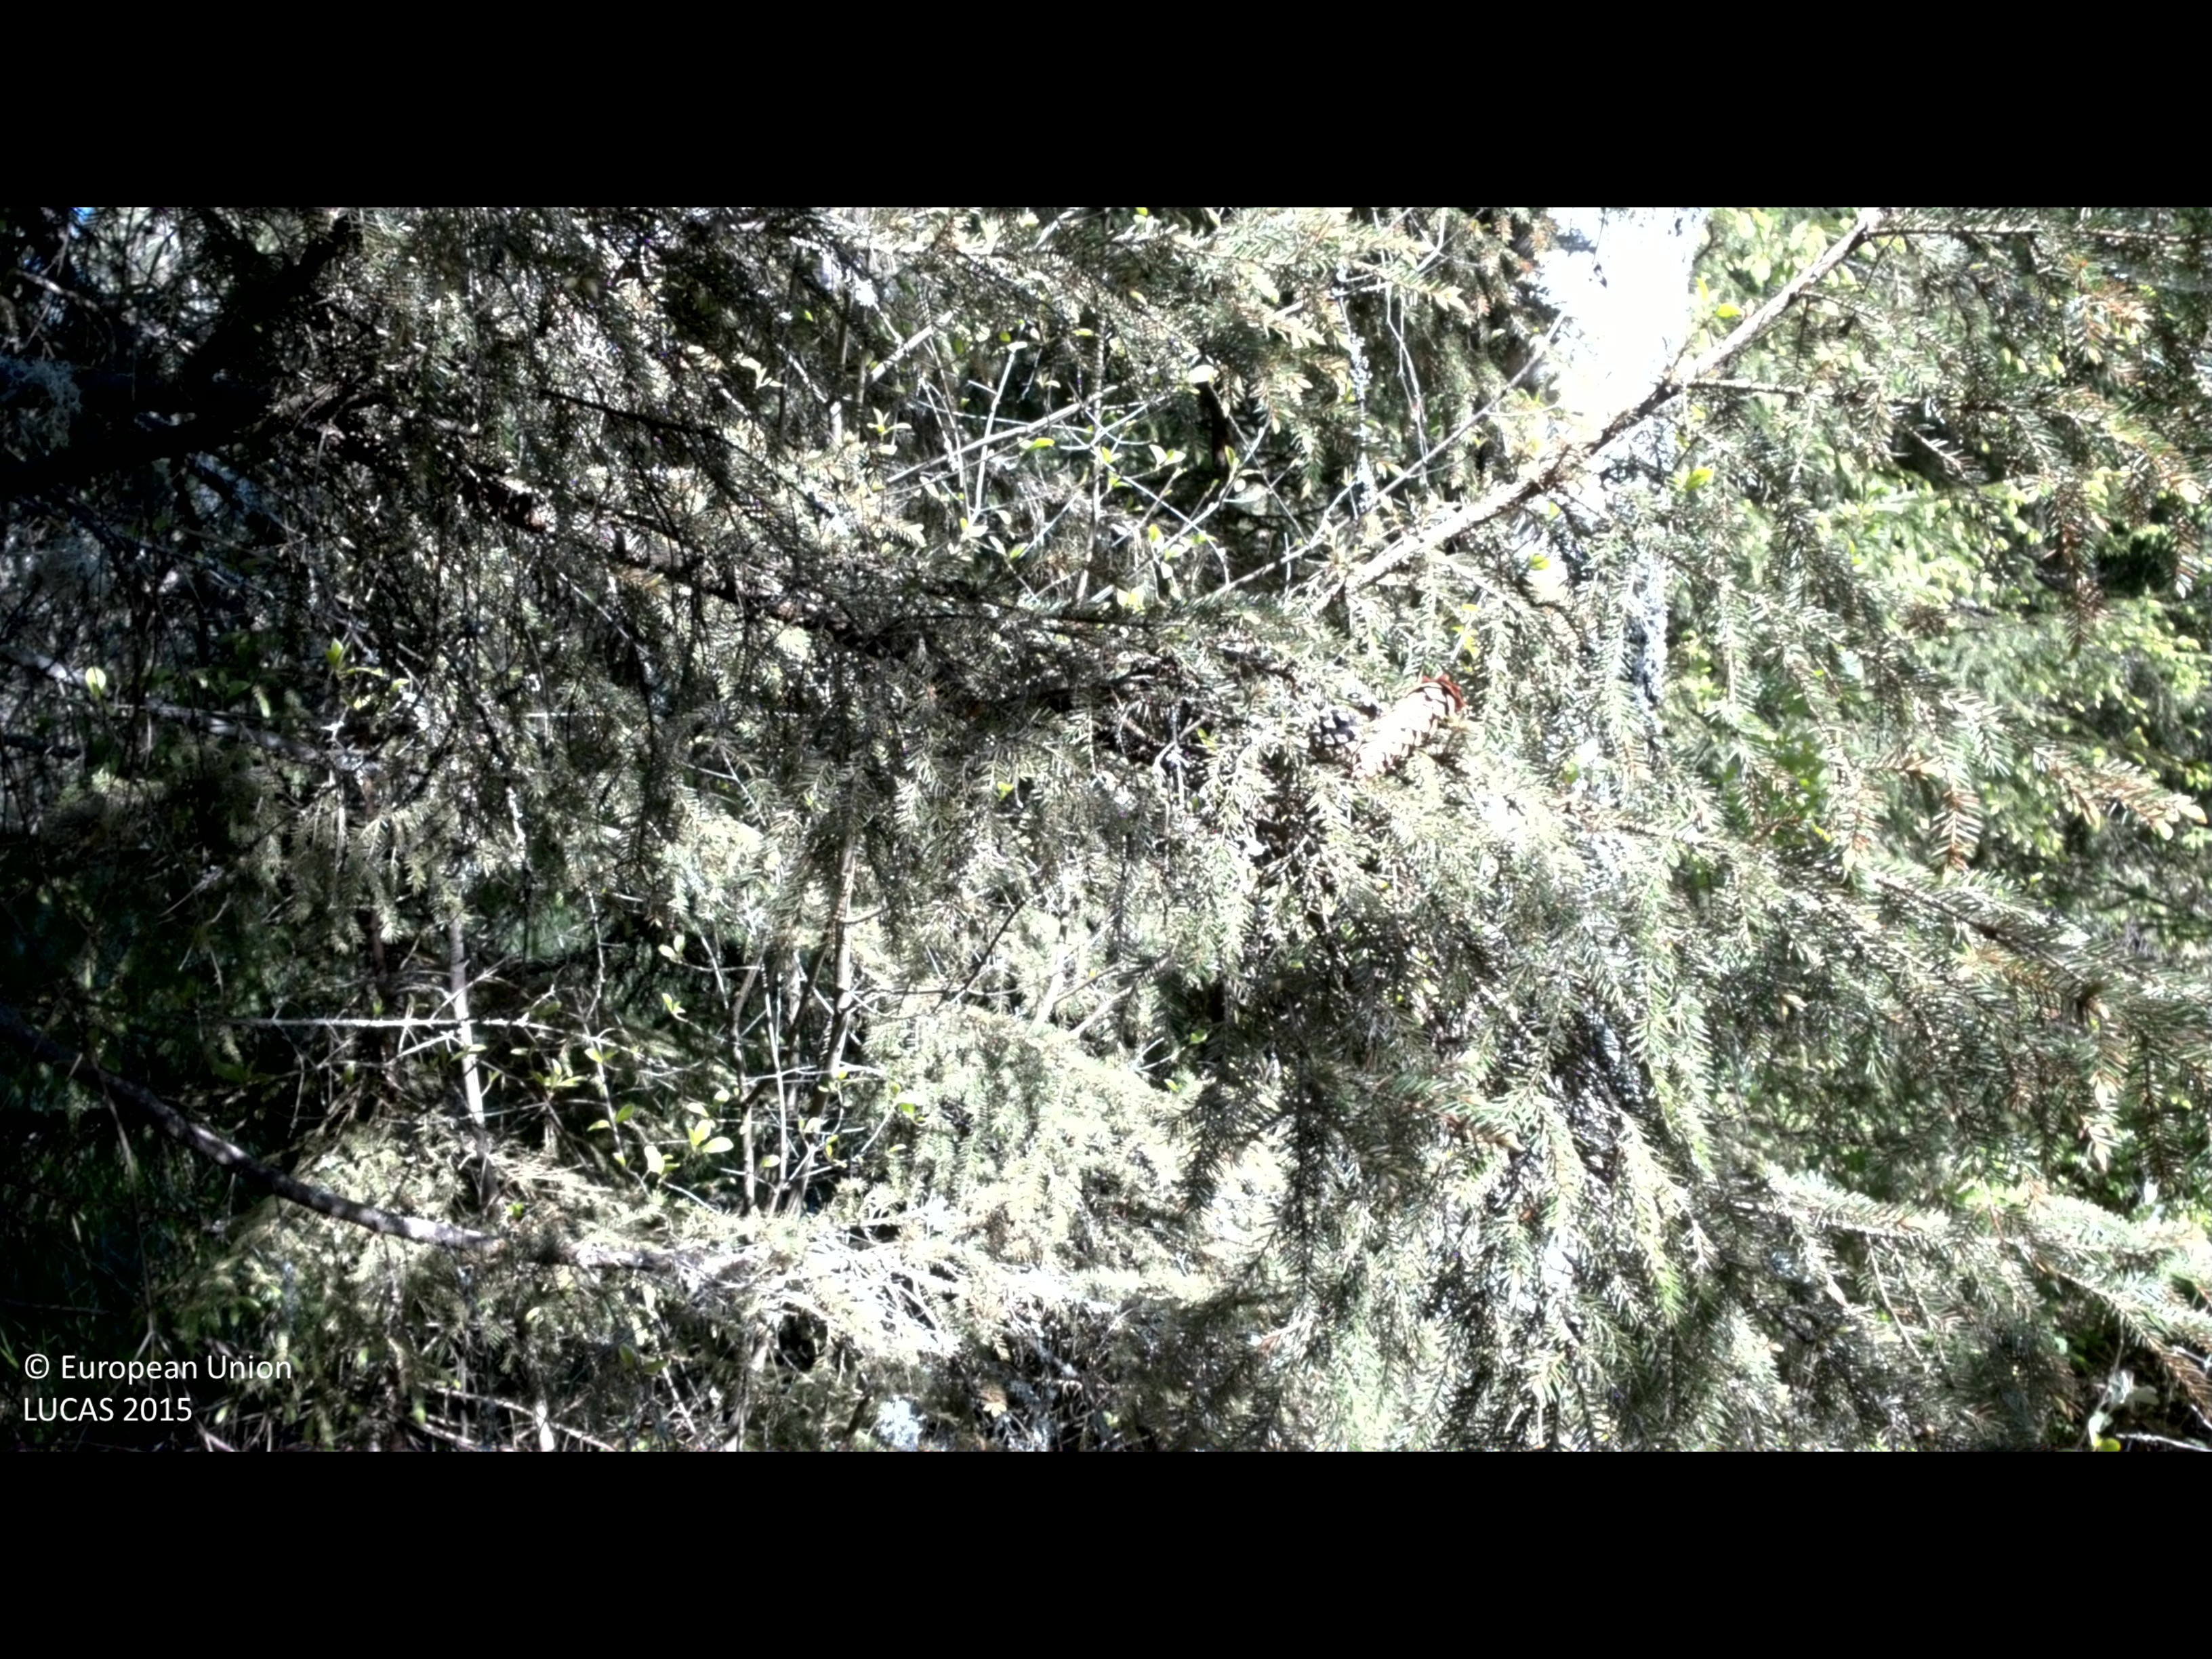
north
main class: Woodland
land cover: Spruce dominated mixed woodland
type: boreal forest
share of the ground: > 75 %
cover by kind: coniferous forest trees 65 %, broadleaved forest trees 25 %, shrubs 5 %, herbaceous plants 5 %
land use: Forestry
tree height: > 5 m
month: May
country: SE
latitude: 57.2832
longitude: 16.1865
